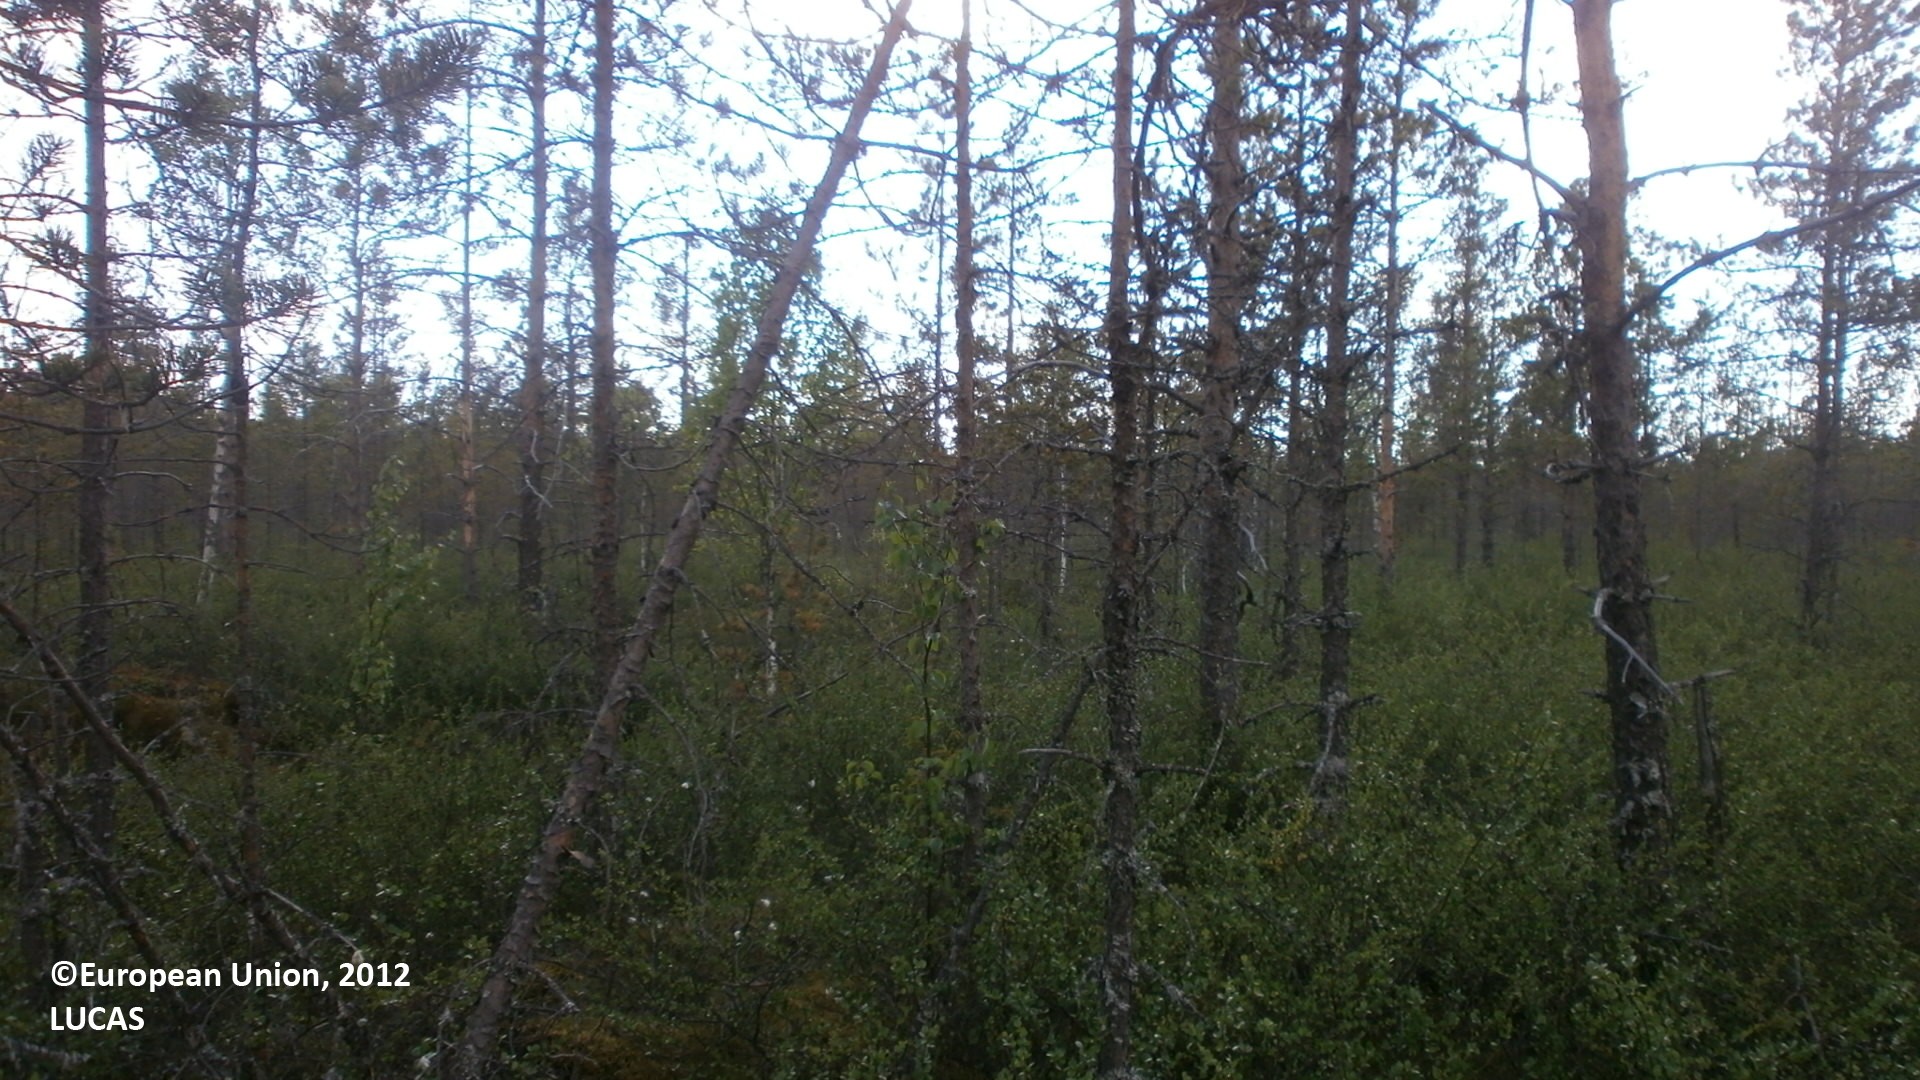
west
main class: Woodland
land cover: Pine dominated coniferous woodland
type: mire and swamp forests
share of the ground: 25 - 50 %
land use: Forestry
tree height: > 5 m
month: June
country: FI
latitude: 64.0503
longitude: 25.7289
